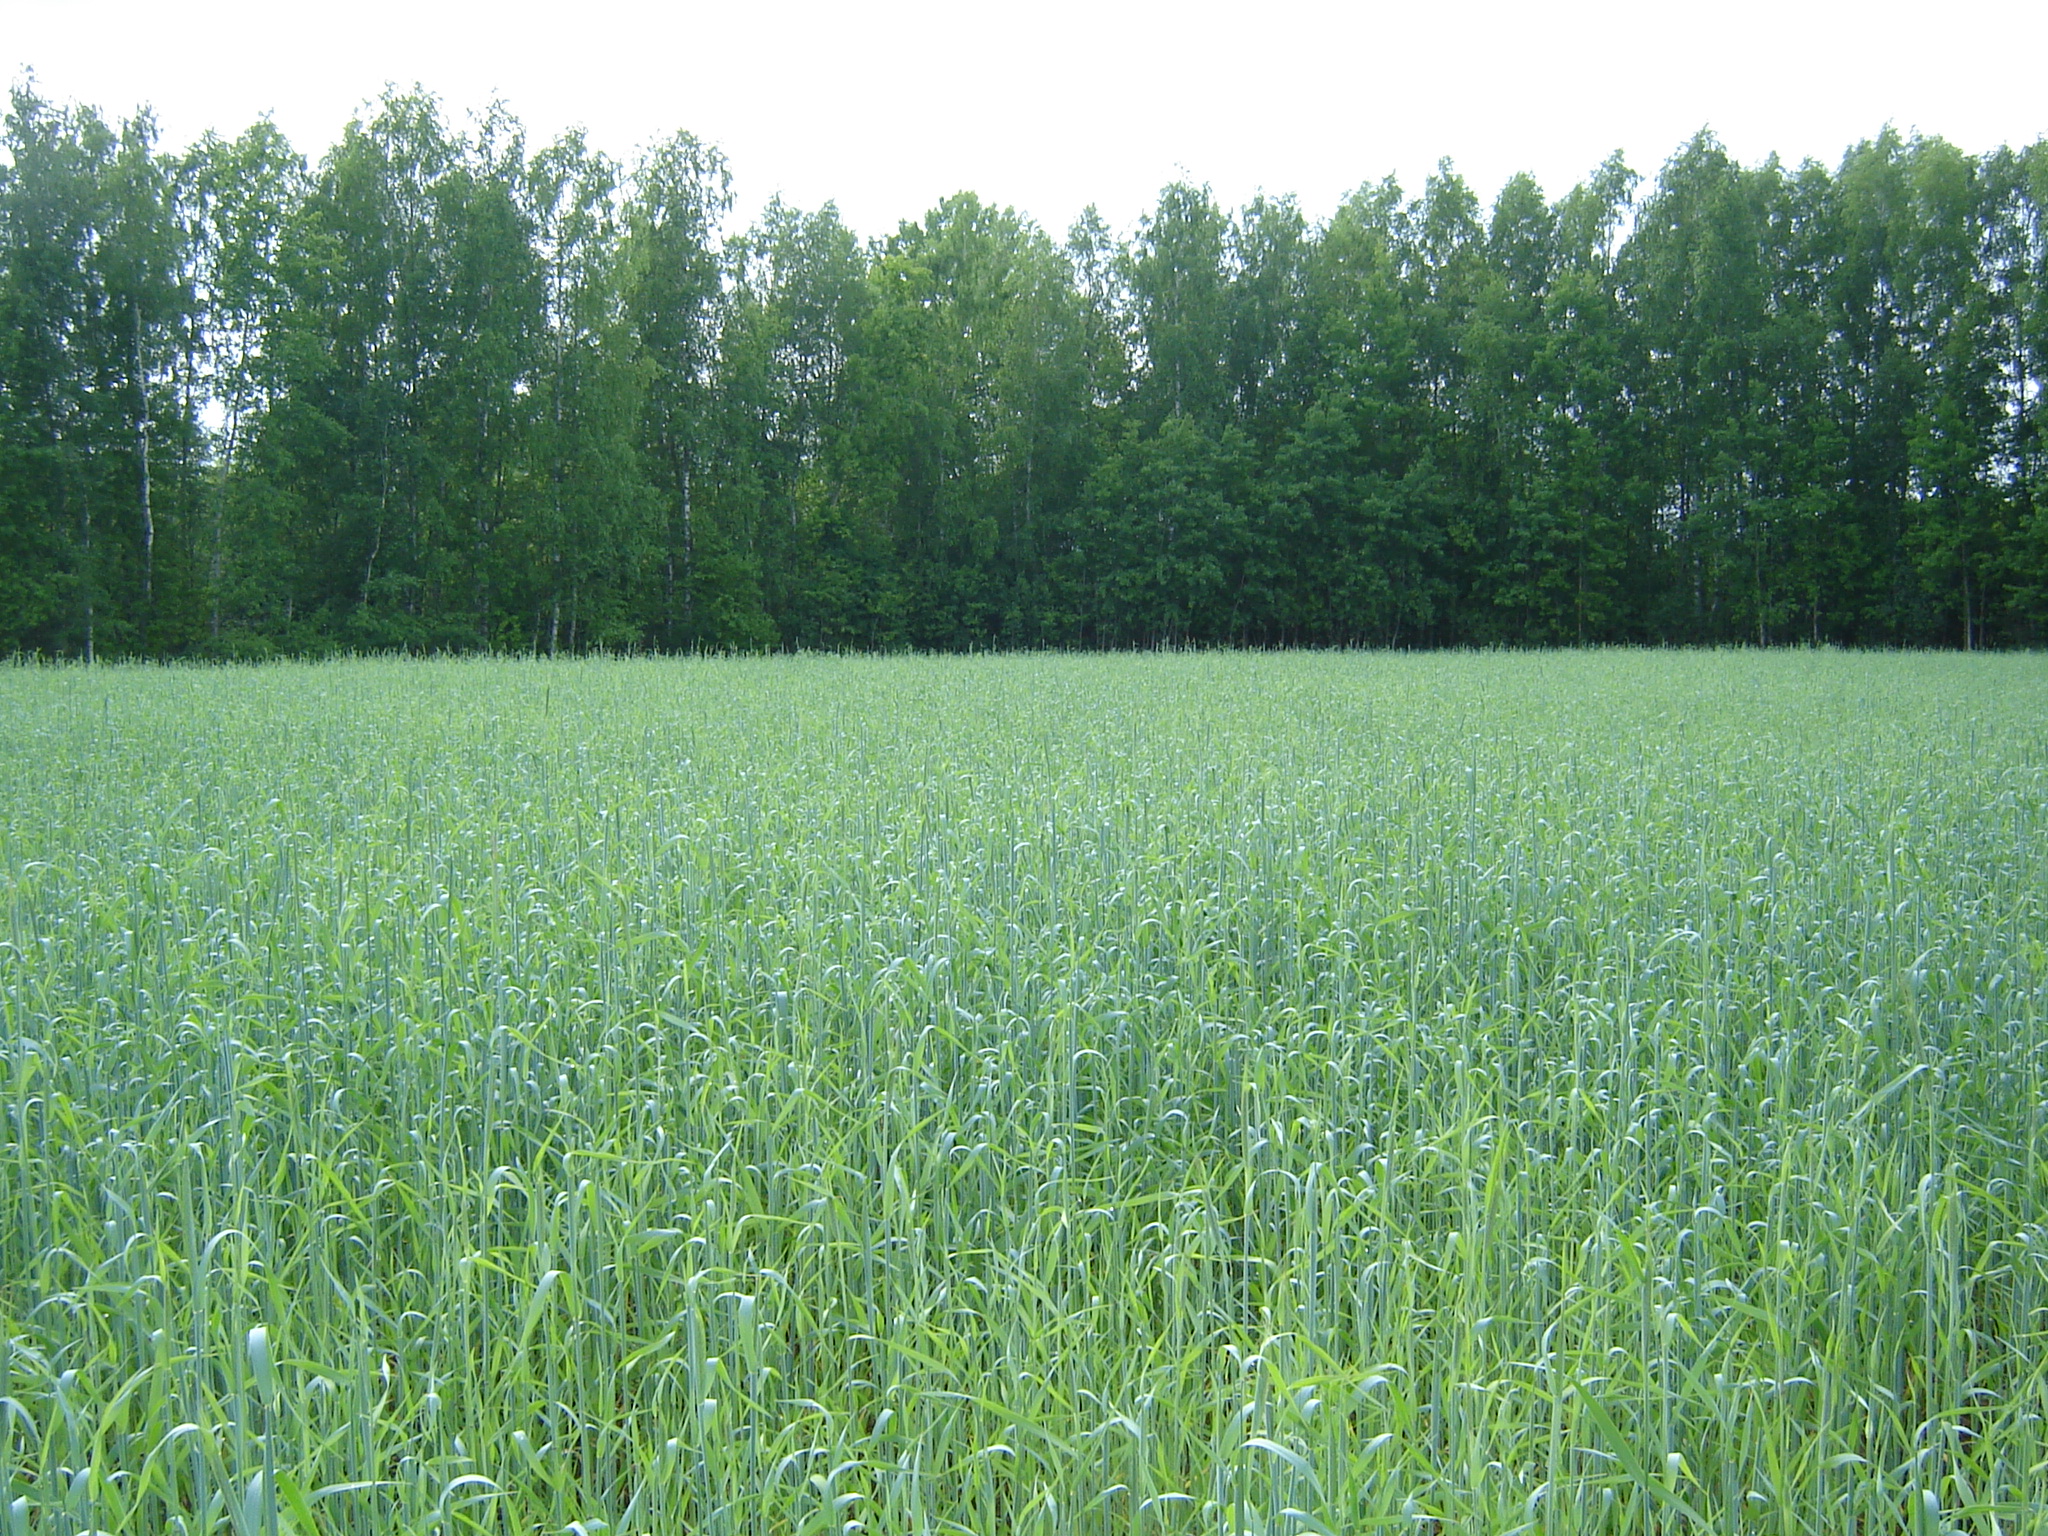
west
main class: Cropland
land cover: Rye
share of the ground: > 75 %
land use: Agriculture (excluding fallow land and kitchen gardens)
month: May
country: LT
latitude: 55.9630
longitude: 25.4190
